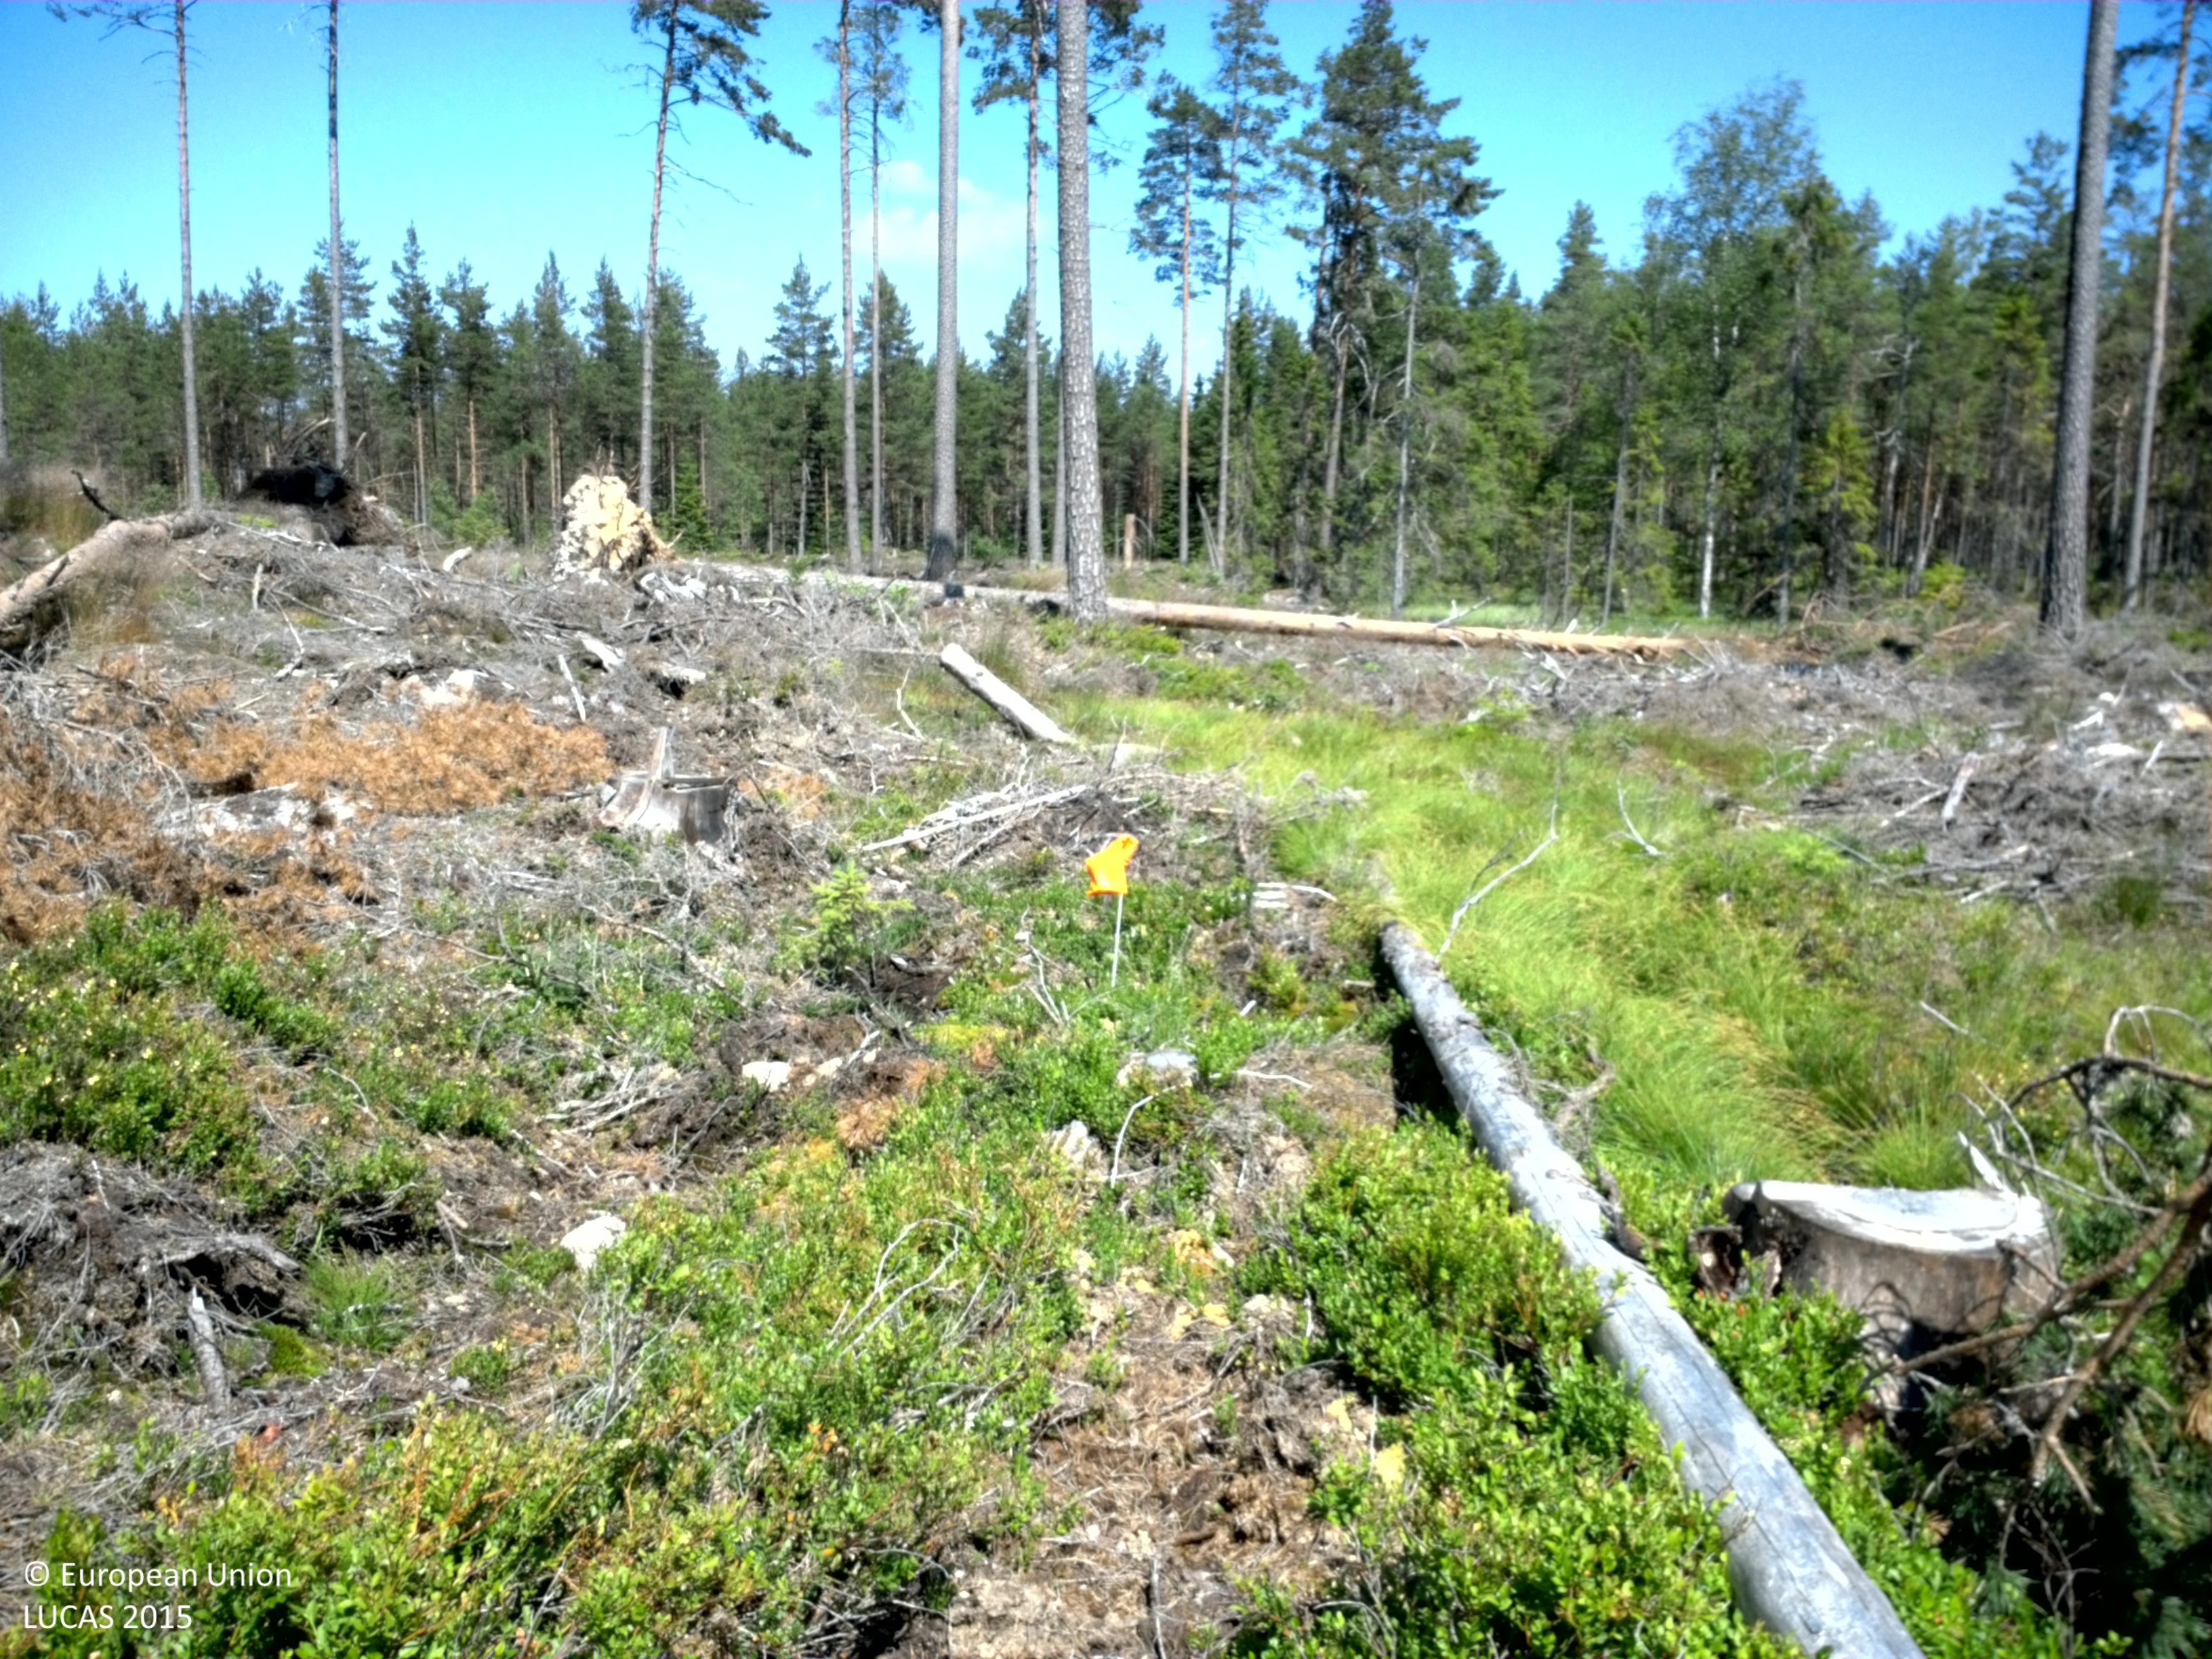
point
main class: Woodland
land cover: Pine dominated coniferous woodland
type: boreal forest
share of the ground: 10 - 25 %
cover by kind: herbaceous plants 60 %, lichens and mosses 30 %, coniferous forest trees 10 %
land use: Forestry
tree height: > 5 m
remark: Clear cut
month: July
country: SE
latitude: 58.7712
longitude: 14.6100
